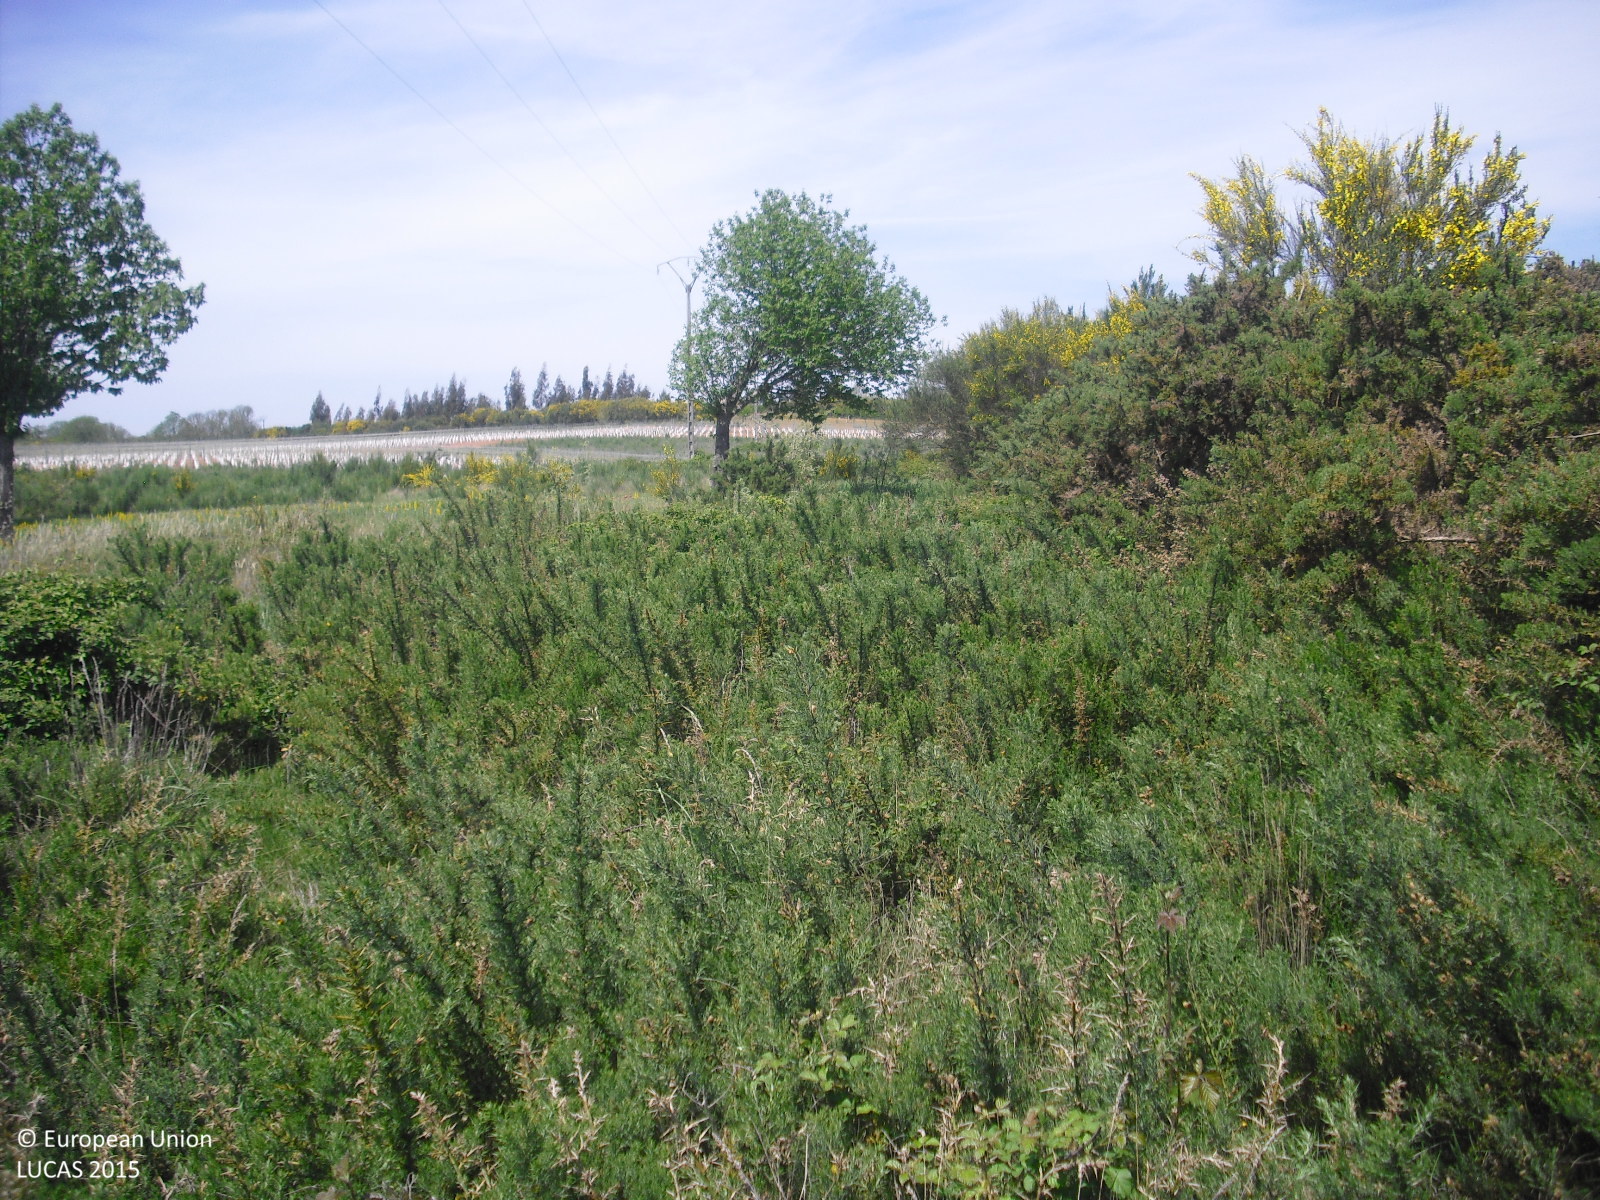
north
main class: Shrubland
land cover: Shrubland with sparse tree cover
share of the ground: > 75 %
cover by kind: shrubs 95 %, broadleaved forest trees 5 %
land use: Abandoned areas
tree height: < 5 m
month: May
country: ES
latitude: 41.9156
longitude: -7.3592
